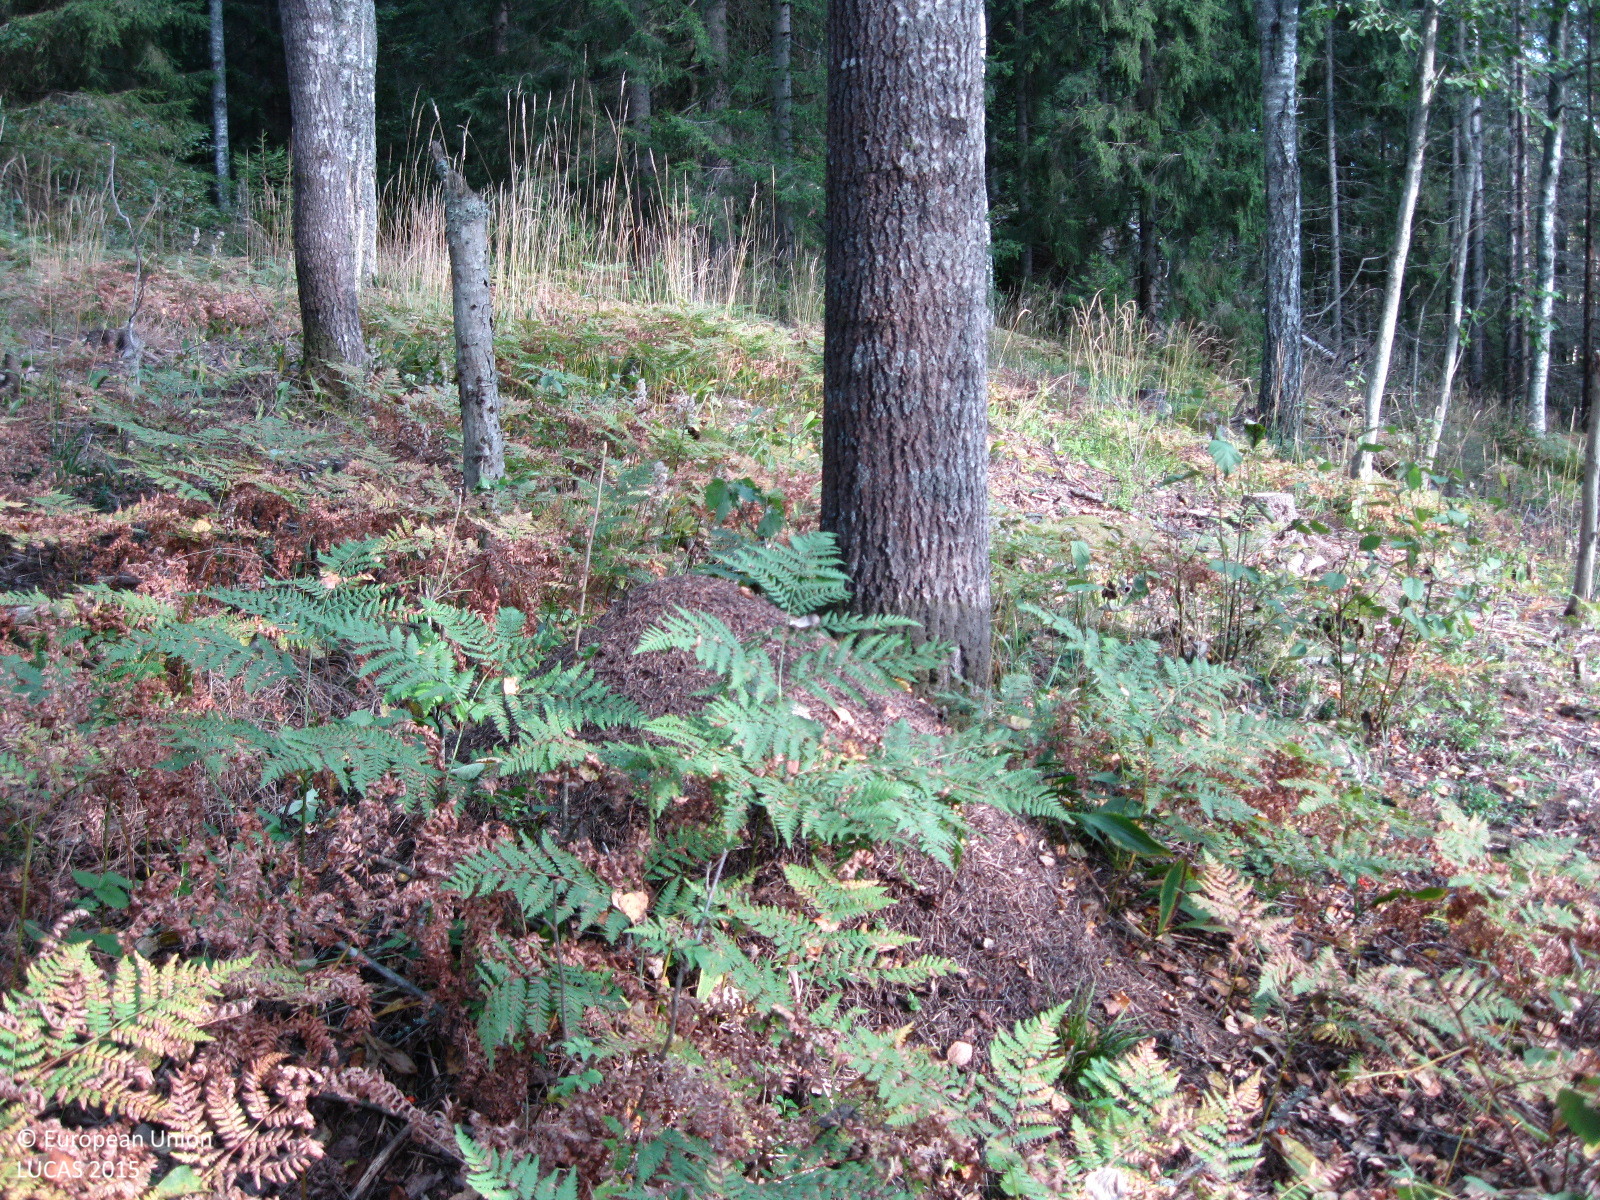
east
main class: Woodland
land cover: Broadleaved woodland
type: boreal forest
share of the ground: > 75 %
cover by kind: broadleaved forest trees 65 %, herbaceous plants 15 %, coniferous forest trees 10 %, unconsolidated bare surface 10 %
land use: Forestry
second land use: Amenities, museums, leisure
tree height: > 5 m
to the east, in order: Broadleaved woodland; Spruce dominated coniferous woodland; Other mixed woodland; Other coniferous woodland
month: September
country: FI
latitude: 60.3421
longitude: 24.5111
